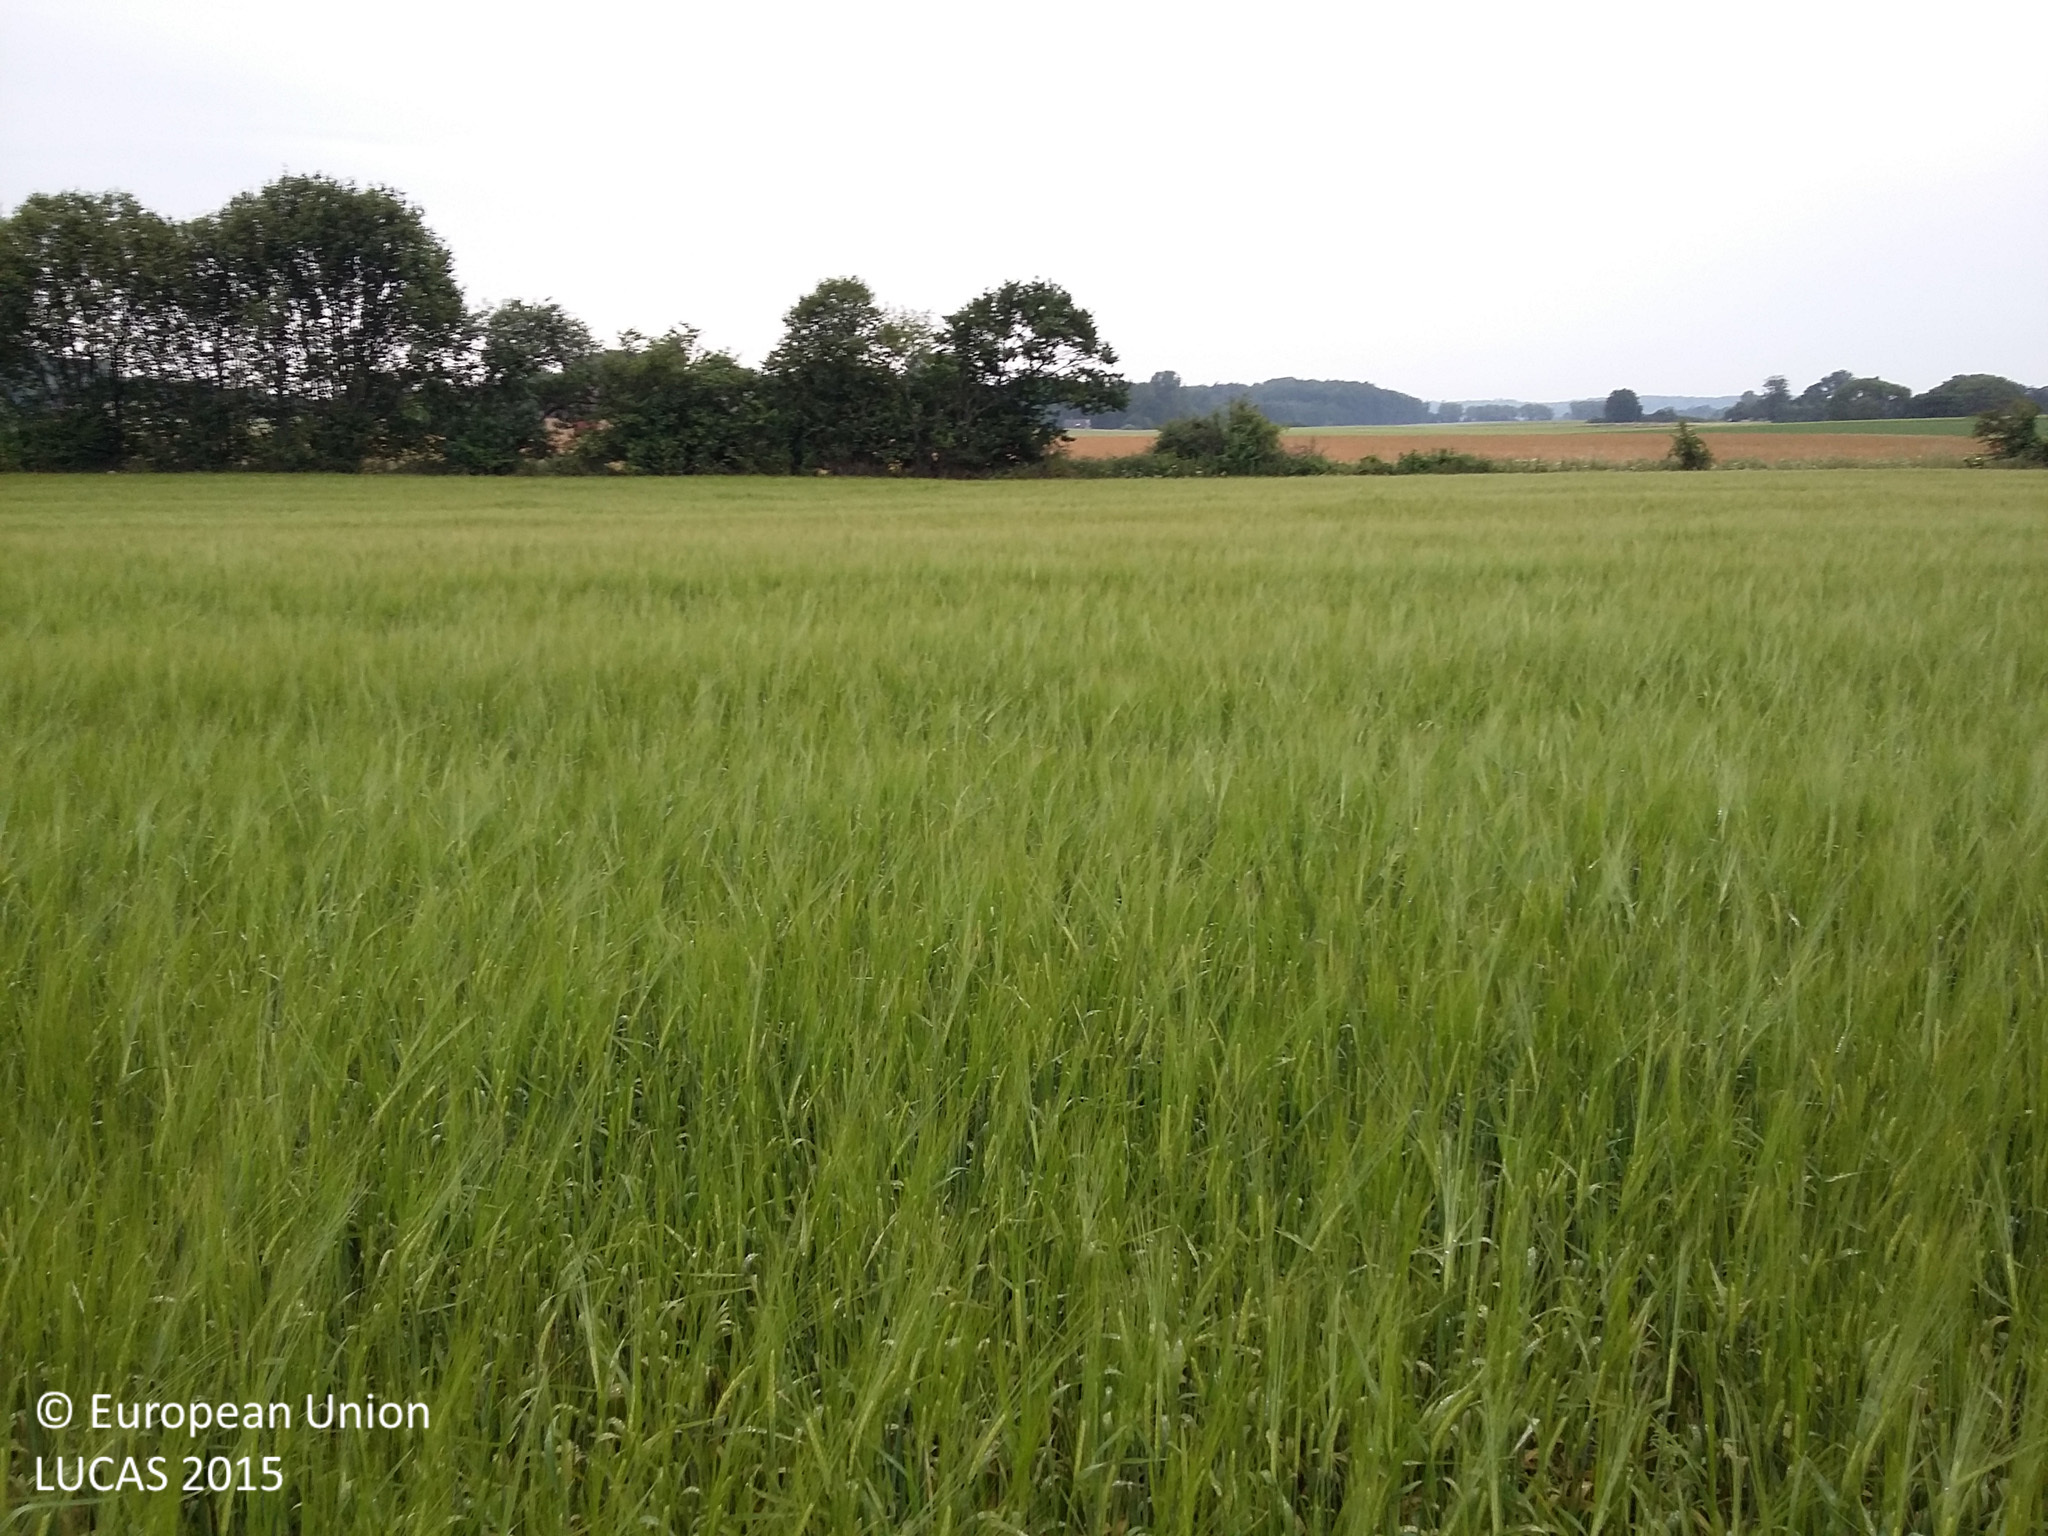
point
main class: Cropland
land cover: Barley
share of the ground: > 75 %
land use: Agriculture (excluding fallow land and kitchen gardens)
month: July
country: DK
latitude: 55.3145
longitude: 11.6216
